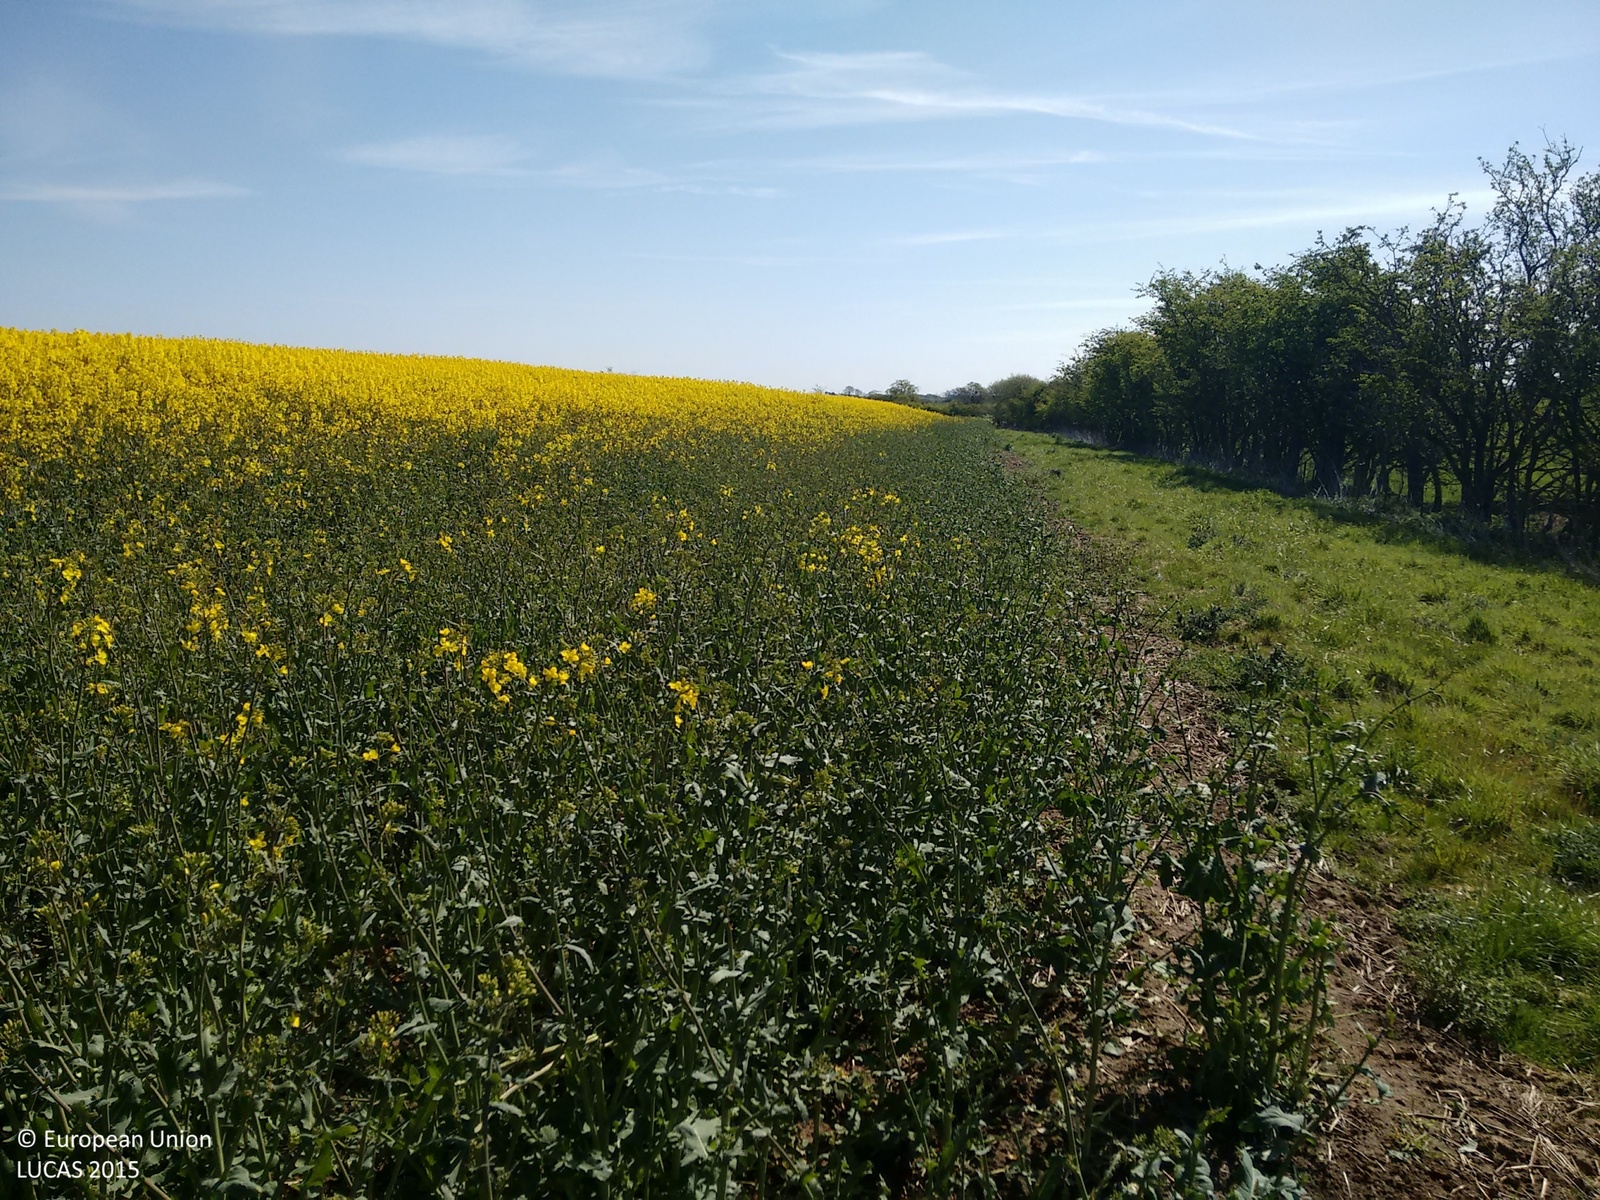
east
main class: Cropland
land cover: Rape and turnip rape
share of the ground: > 75 %
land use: Agriculture (excluding fallow land and kitchen gardens)
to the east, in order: Rape and turnip rape; Fences; Abandoned hedges; Grassland without tree/shrub cover
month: May
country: GB
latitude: 55.2320
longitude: -1.7009
